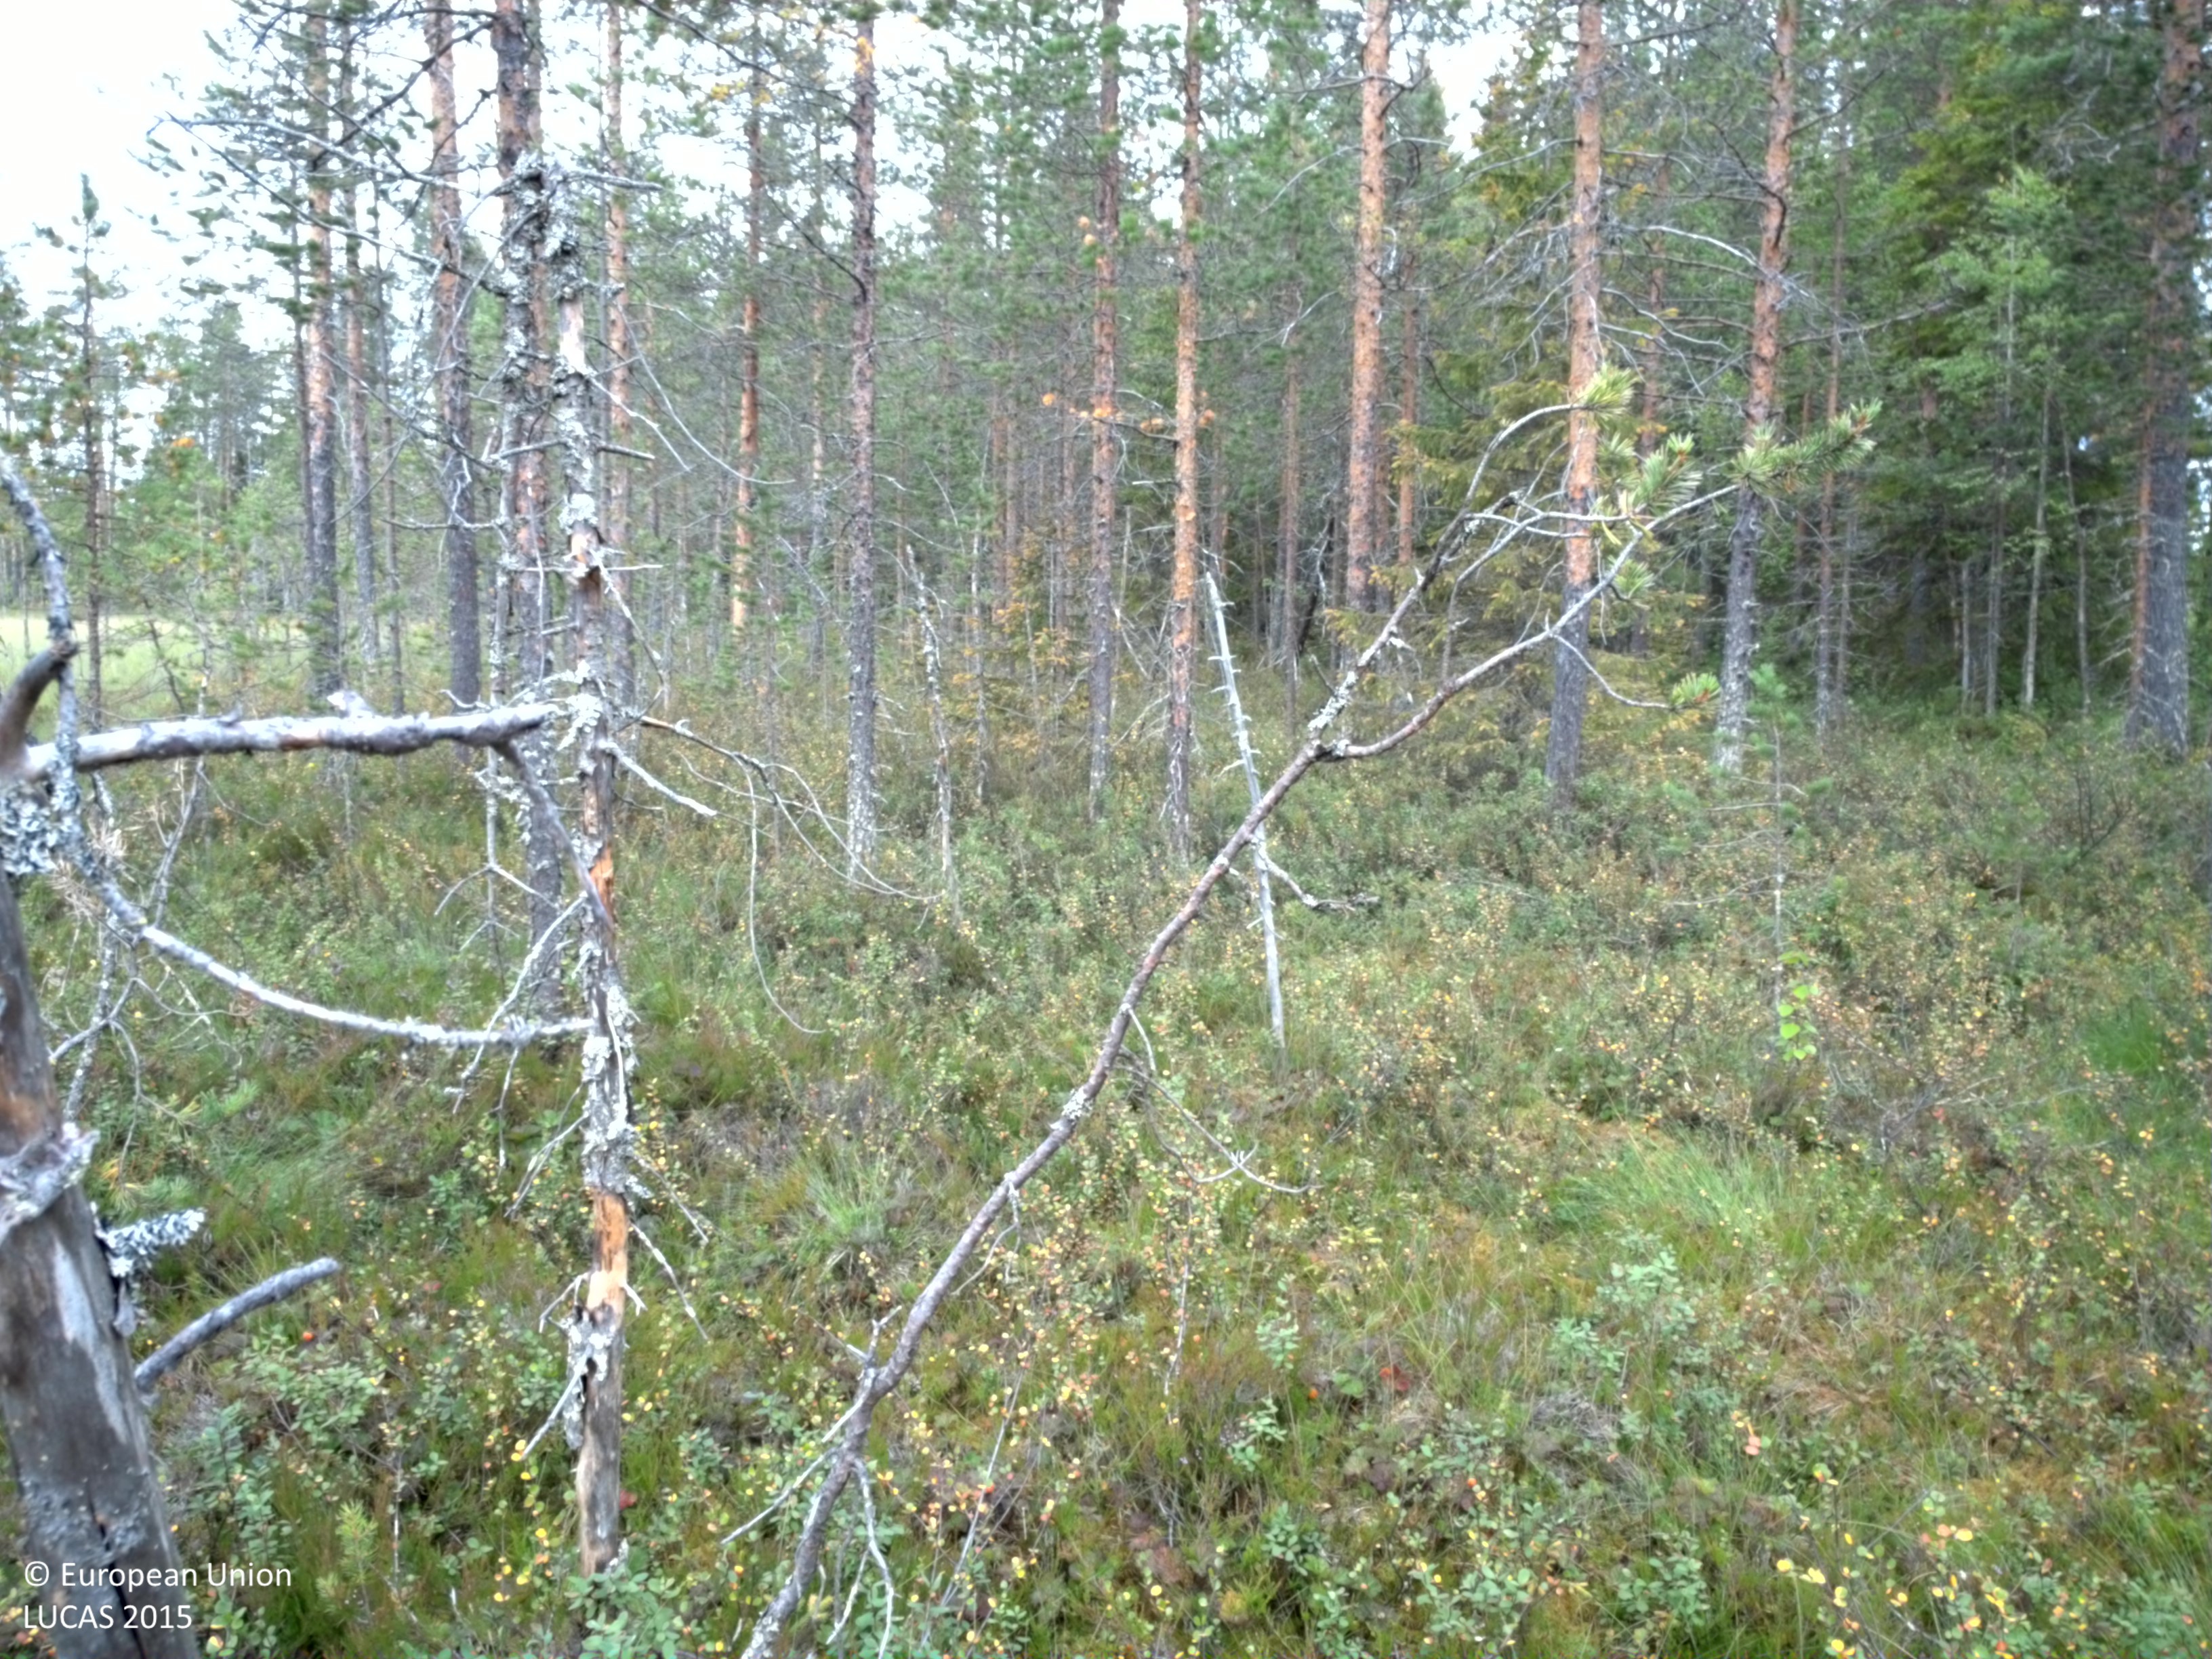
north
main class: Woodland
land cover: Pine dominated coniferous woodland
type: boreal forest
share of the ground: 25 - 50 %
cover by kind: shrubs 70 %, coniferous forest trees 25 %, lichens and mosses 5 %
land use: Forestry
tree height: > 5 m
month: August
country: SE
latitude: 65.9927
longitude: 22.5118
